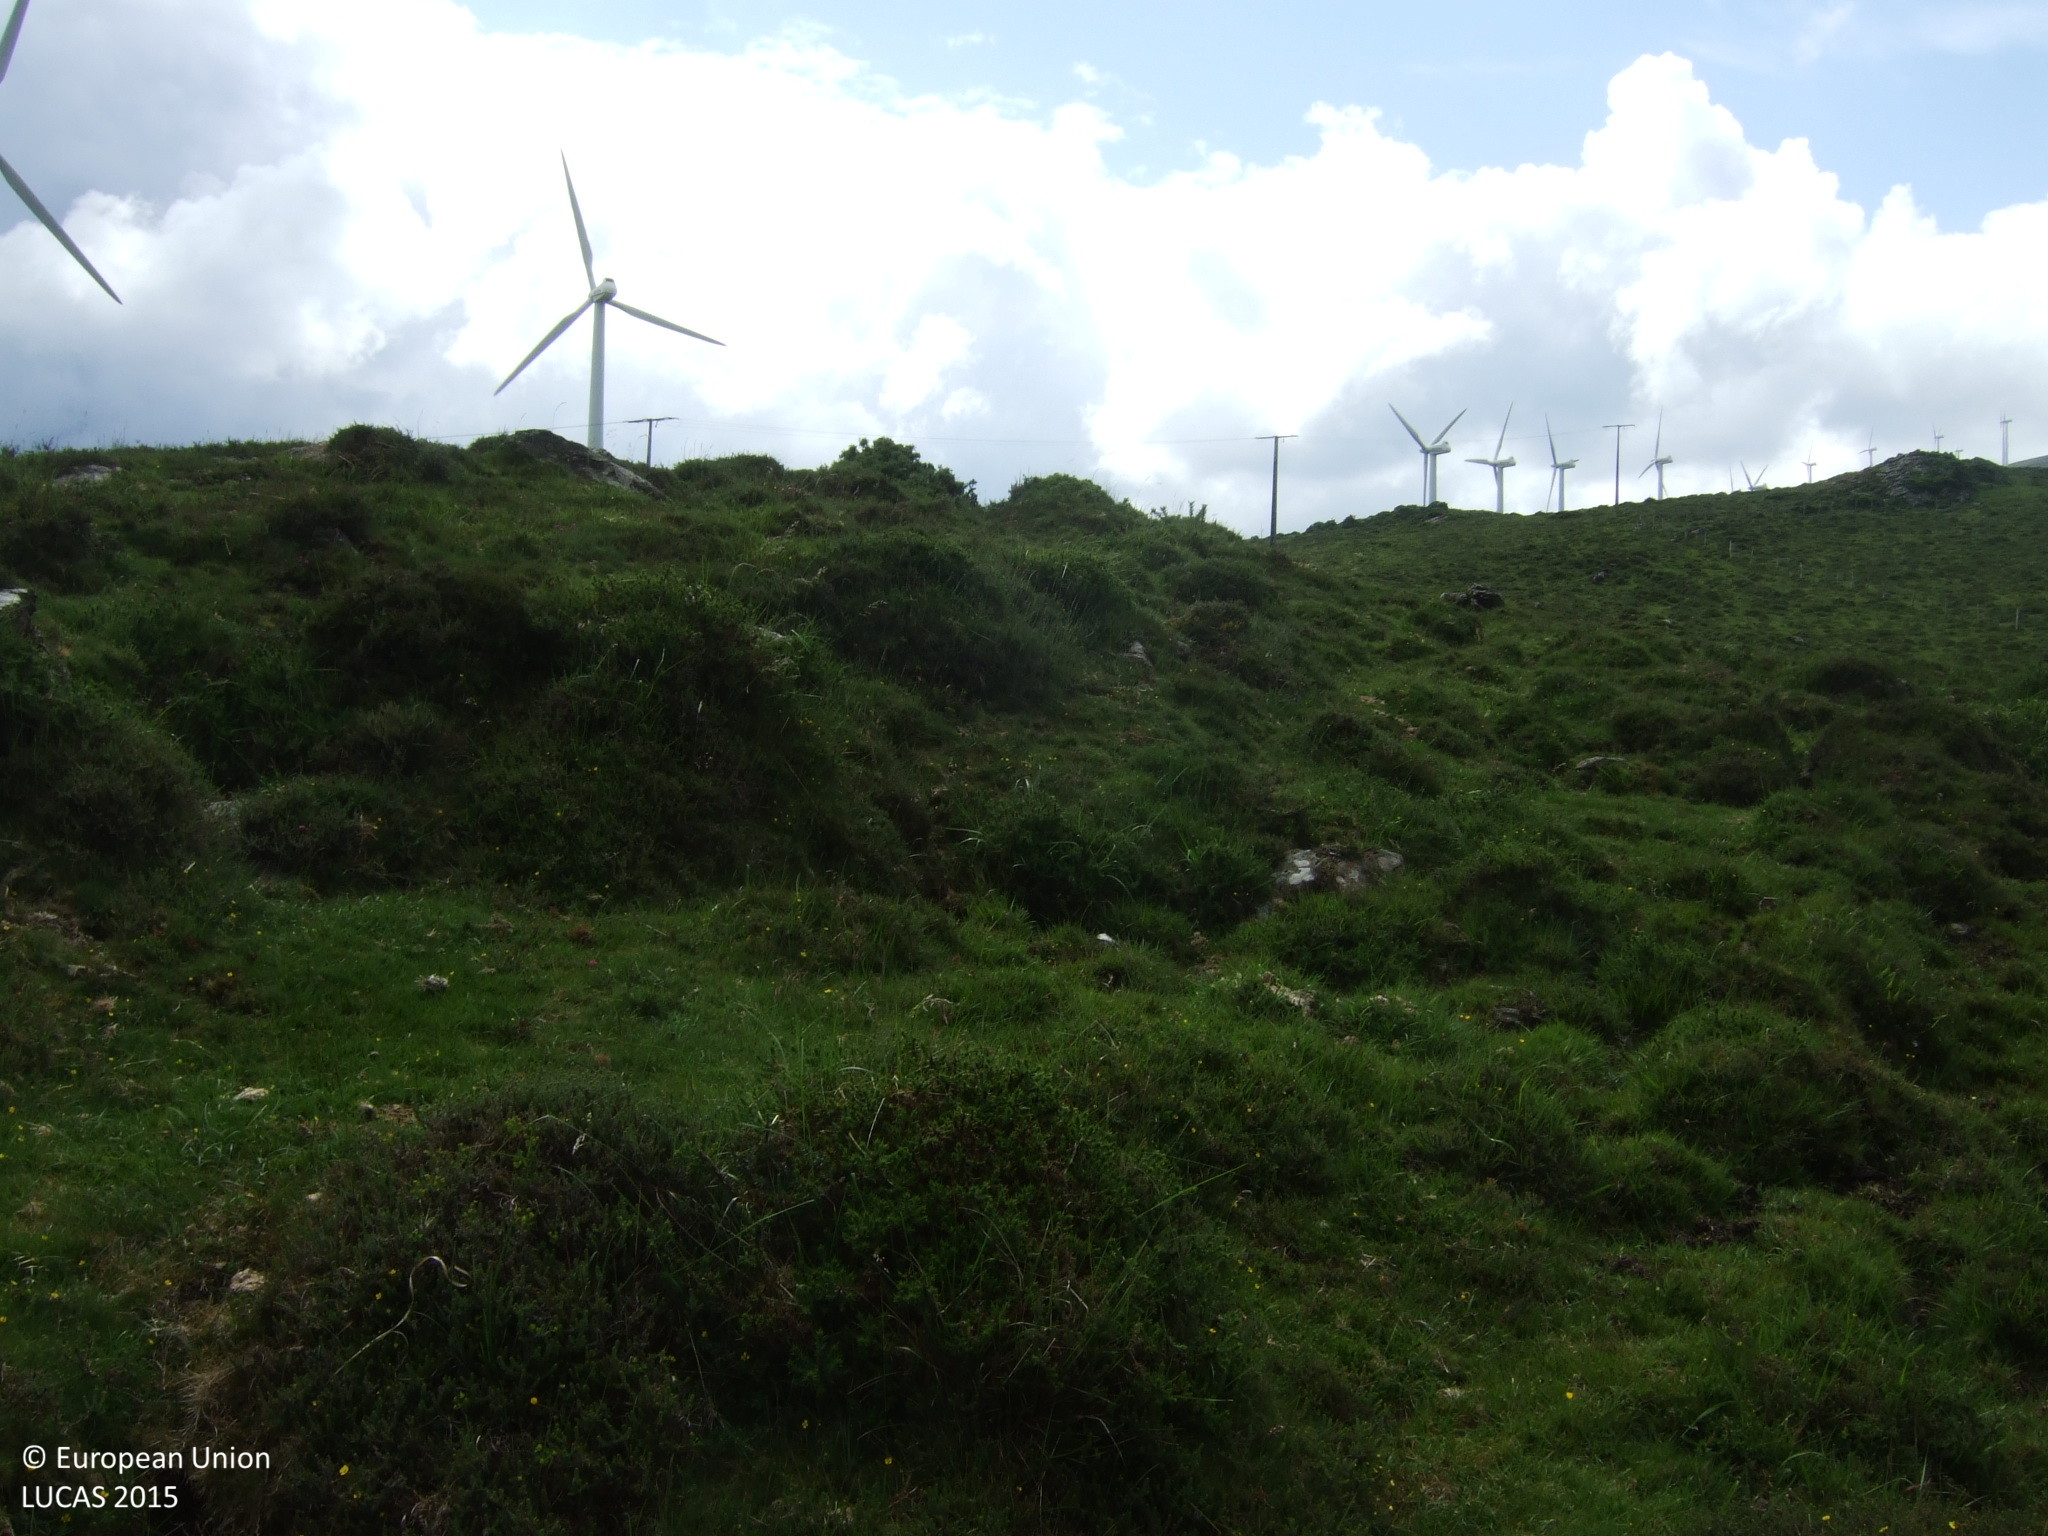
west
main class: Shrubland
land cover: Shrubland without tree cover
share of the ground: > 75 %
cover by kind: herbaceous plants 60 %, shrubs 40 %
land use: Agriculture (excluding fallow land and kitchen gardens)
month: June
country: ES
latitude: 43.4889
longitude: -7.5296
